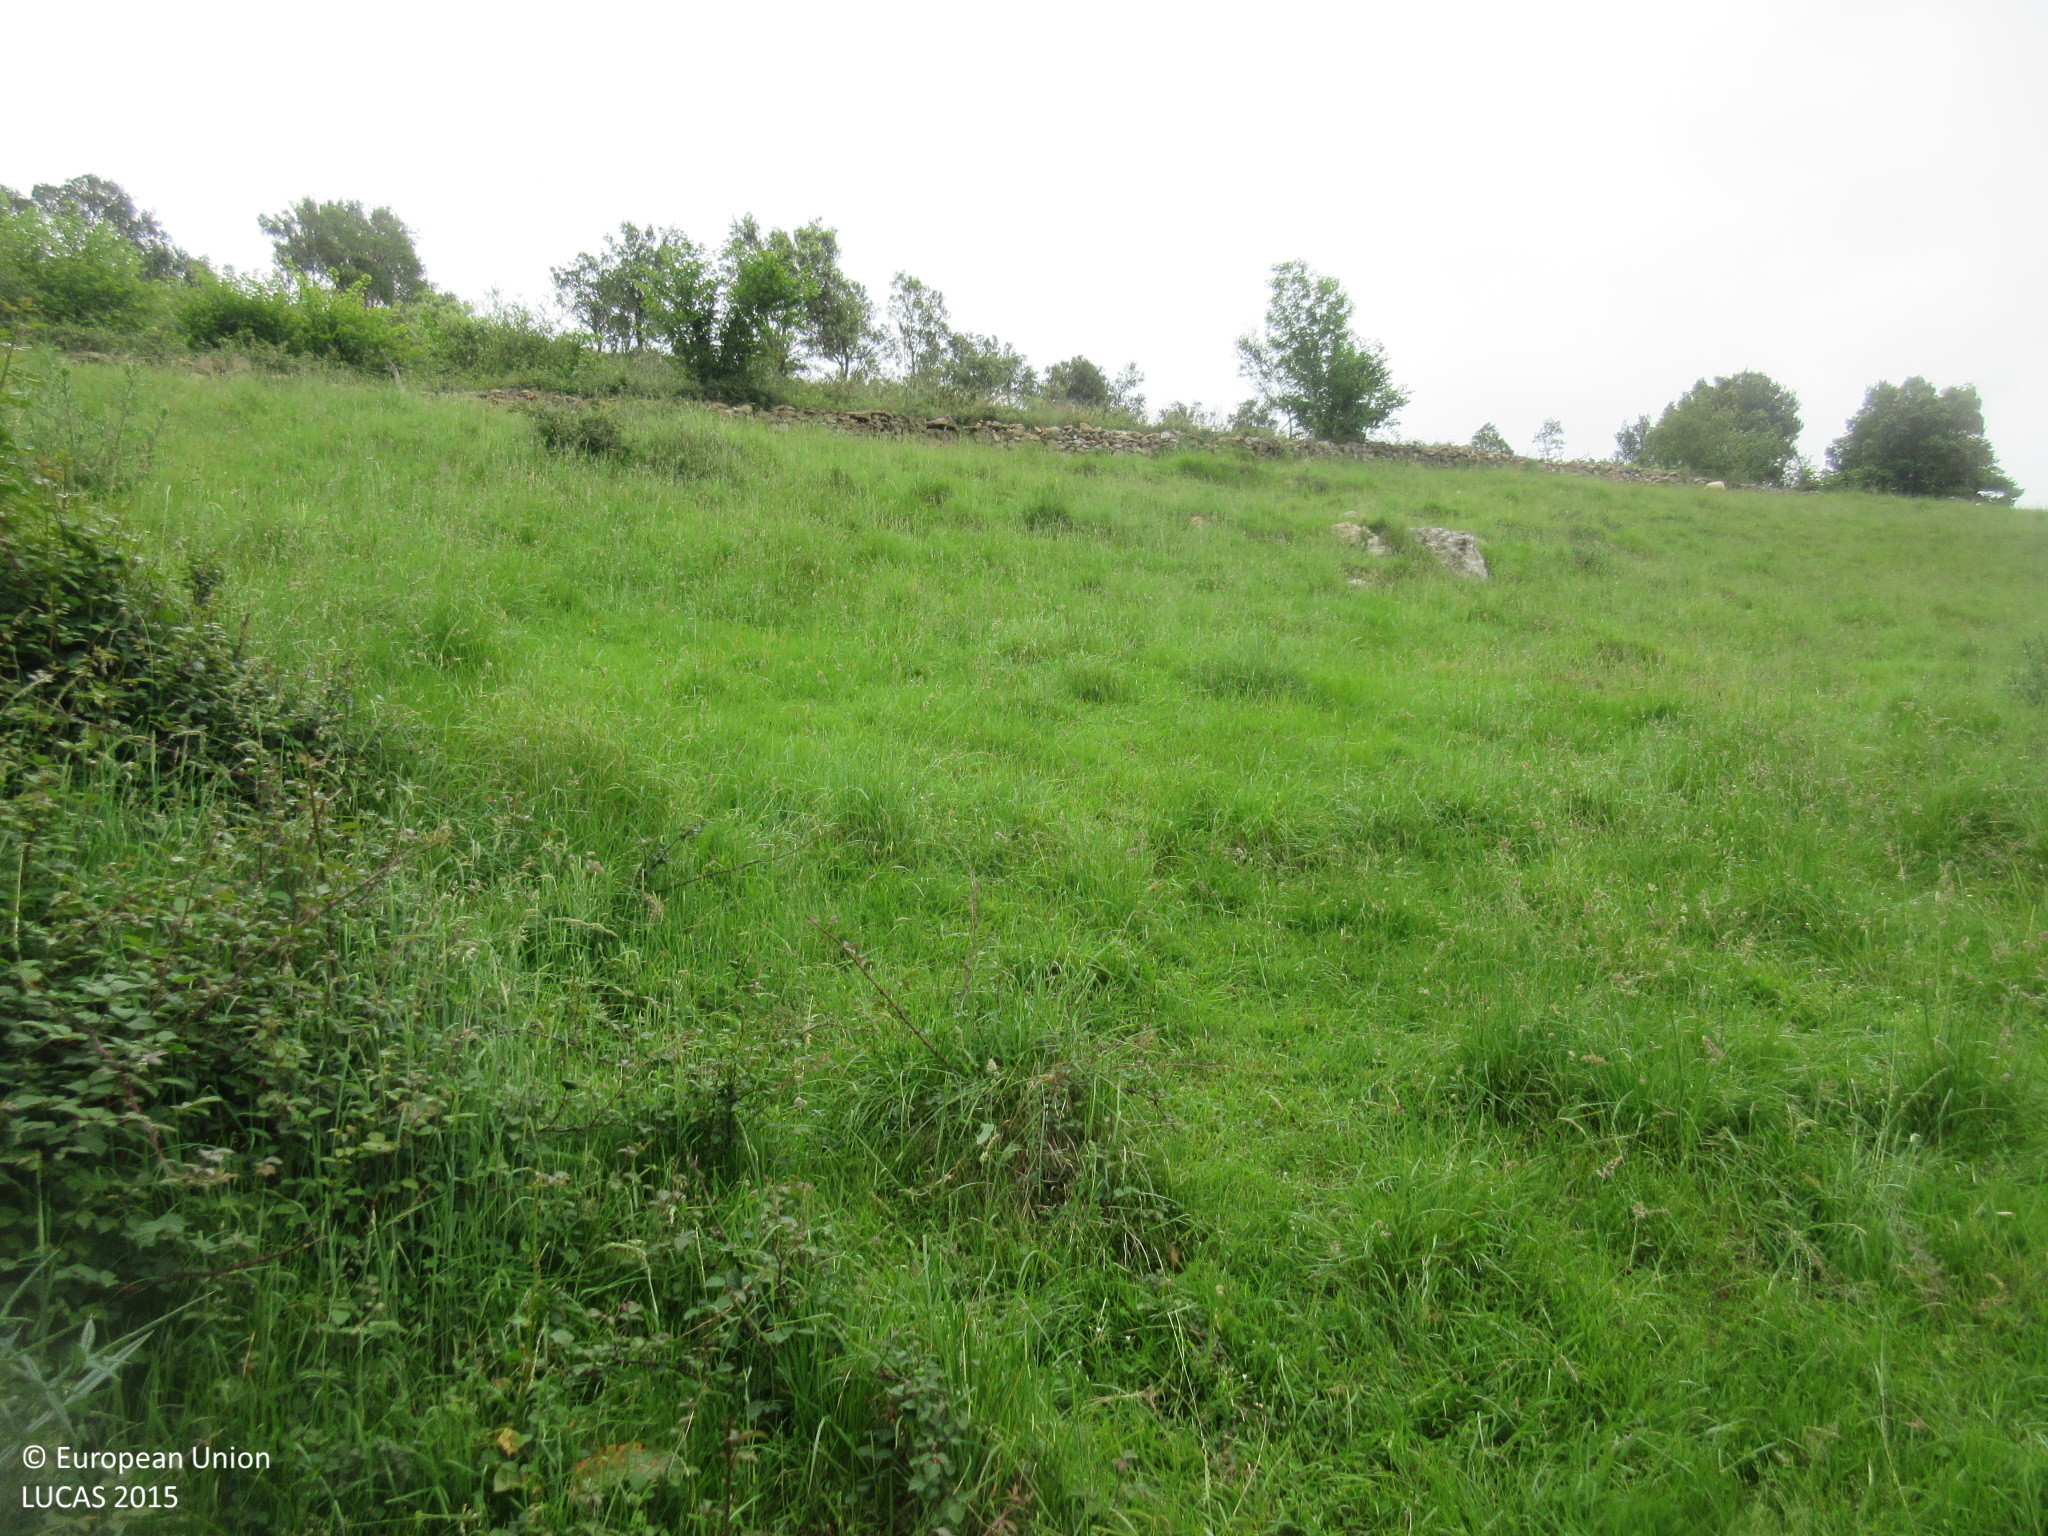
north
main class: Grassland
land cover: Grassland without tree/shrub cover
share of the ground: > 75 %
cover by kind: herbaceous plants 100 %
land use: Agriculture (excluding fallow land and kitchen gardens)
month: June
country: ES
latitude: 43.3374
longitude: -3.6253
